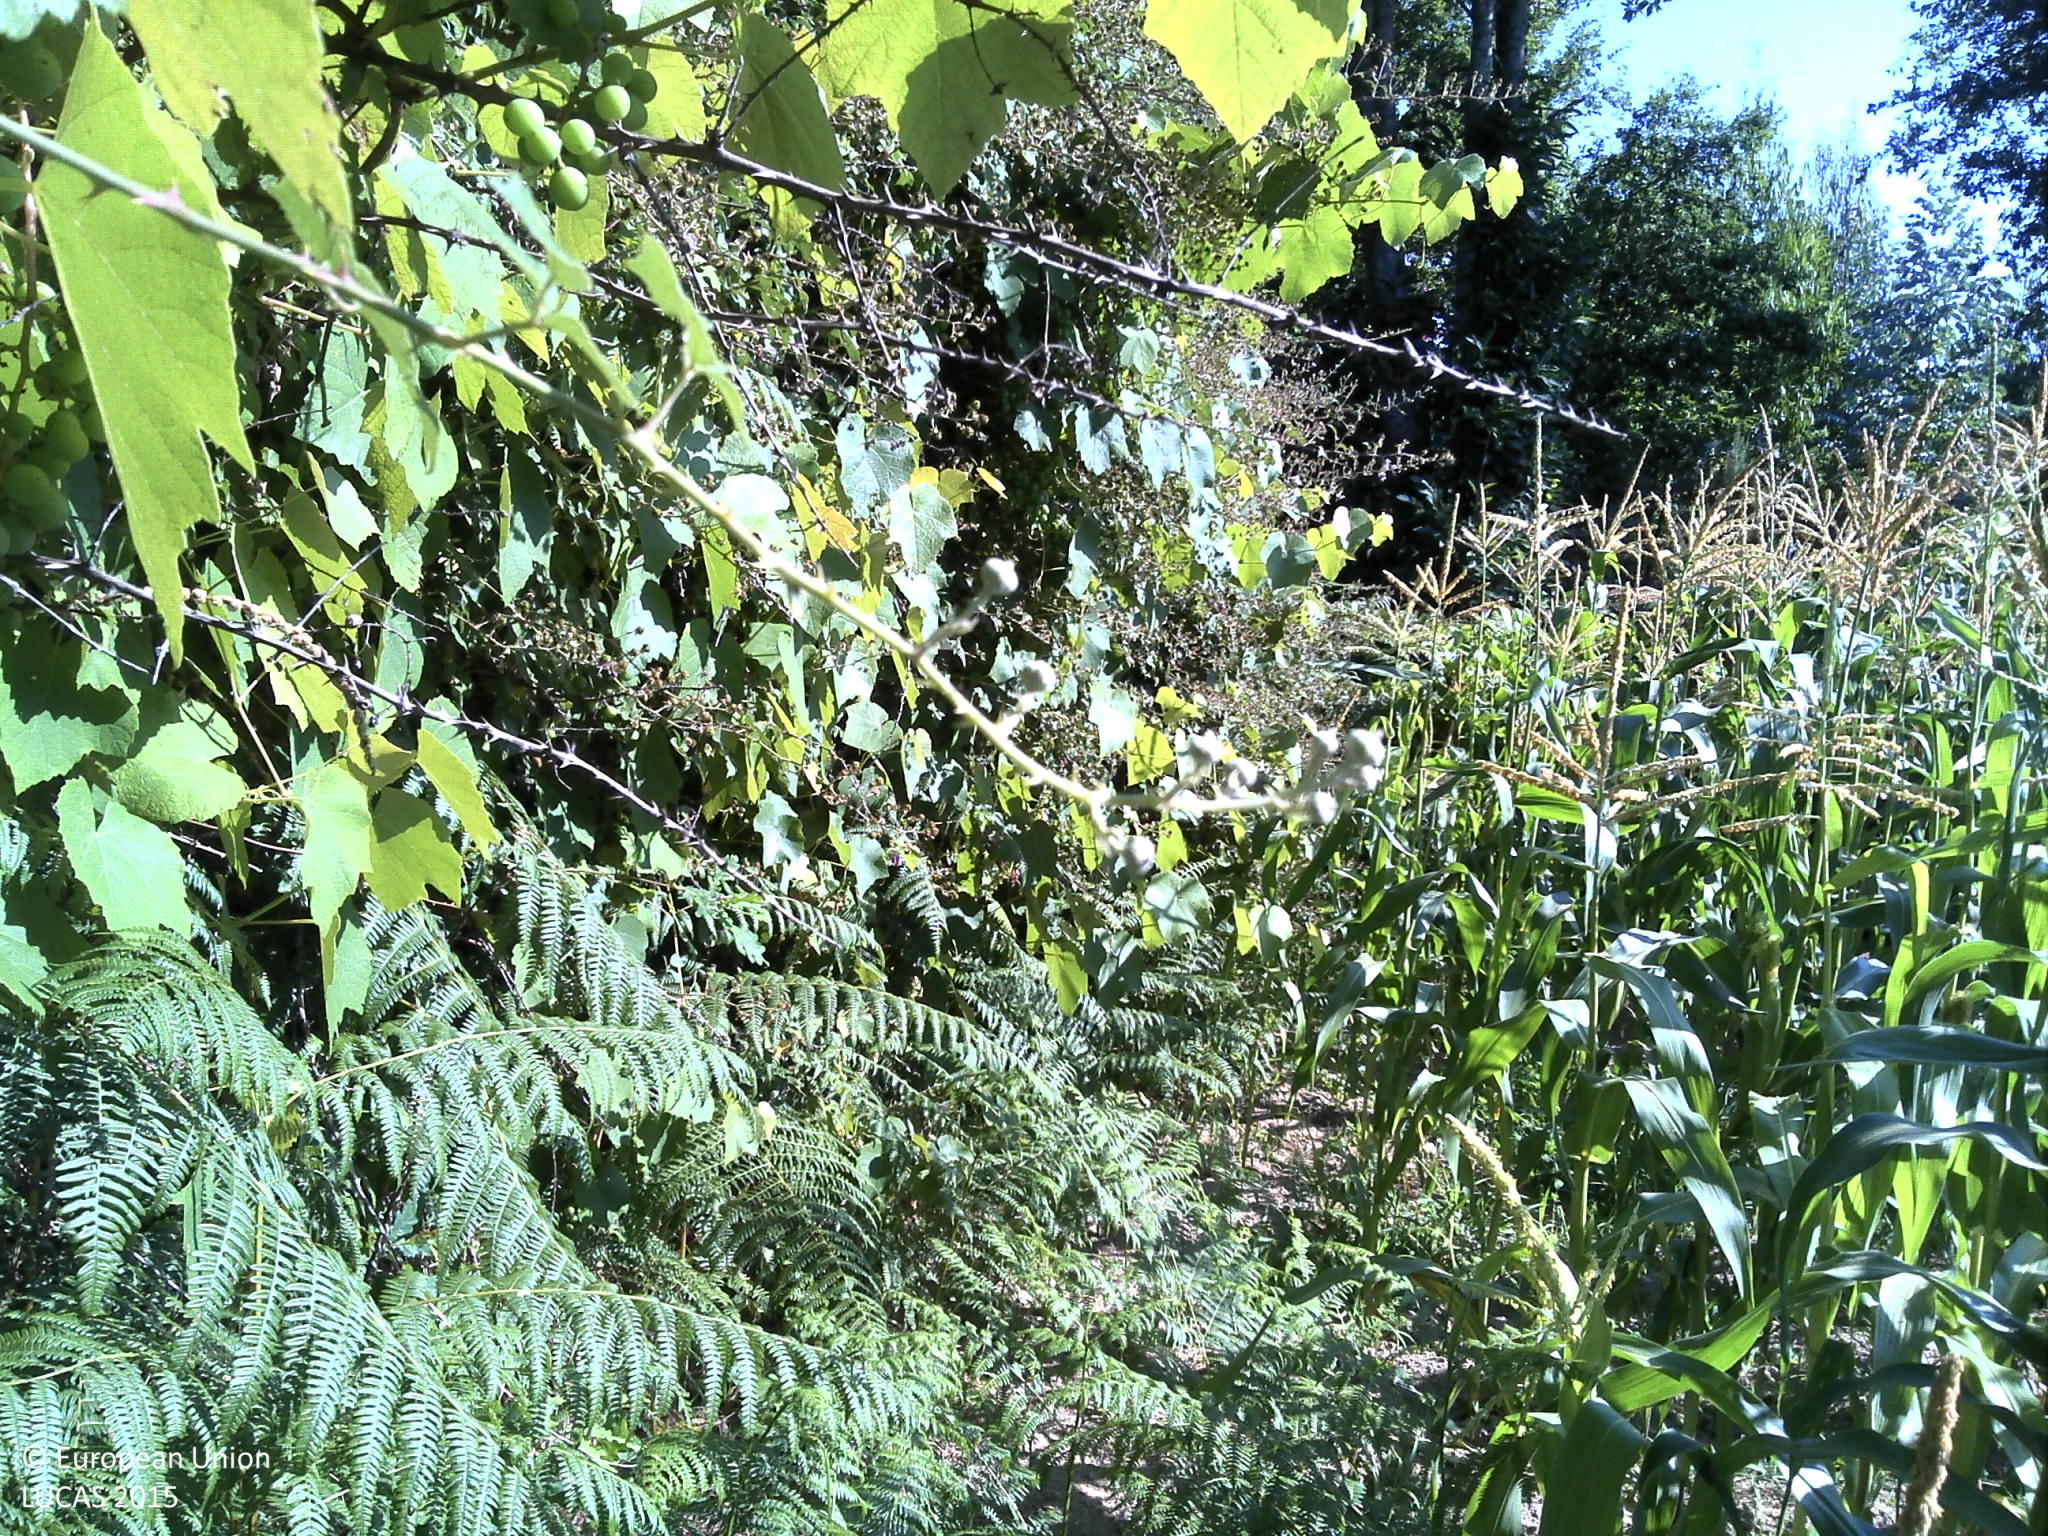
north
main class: Shrubland
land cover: Shrubland with sparse tree cover
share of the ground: > 75 %
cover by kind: shrubs 95 %, broadleaved forest trees 5 %
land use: Semi-natural and natural areas not in use
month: July
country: PT
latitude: 40.8177
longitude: -7.8256
